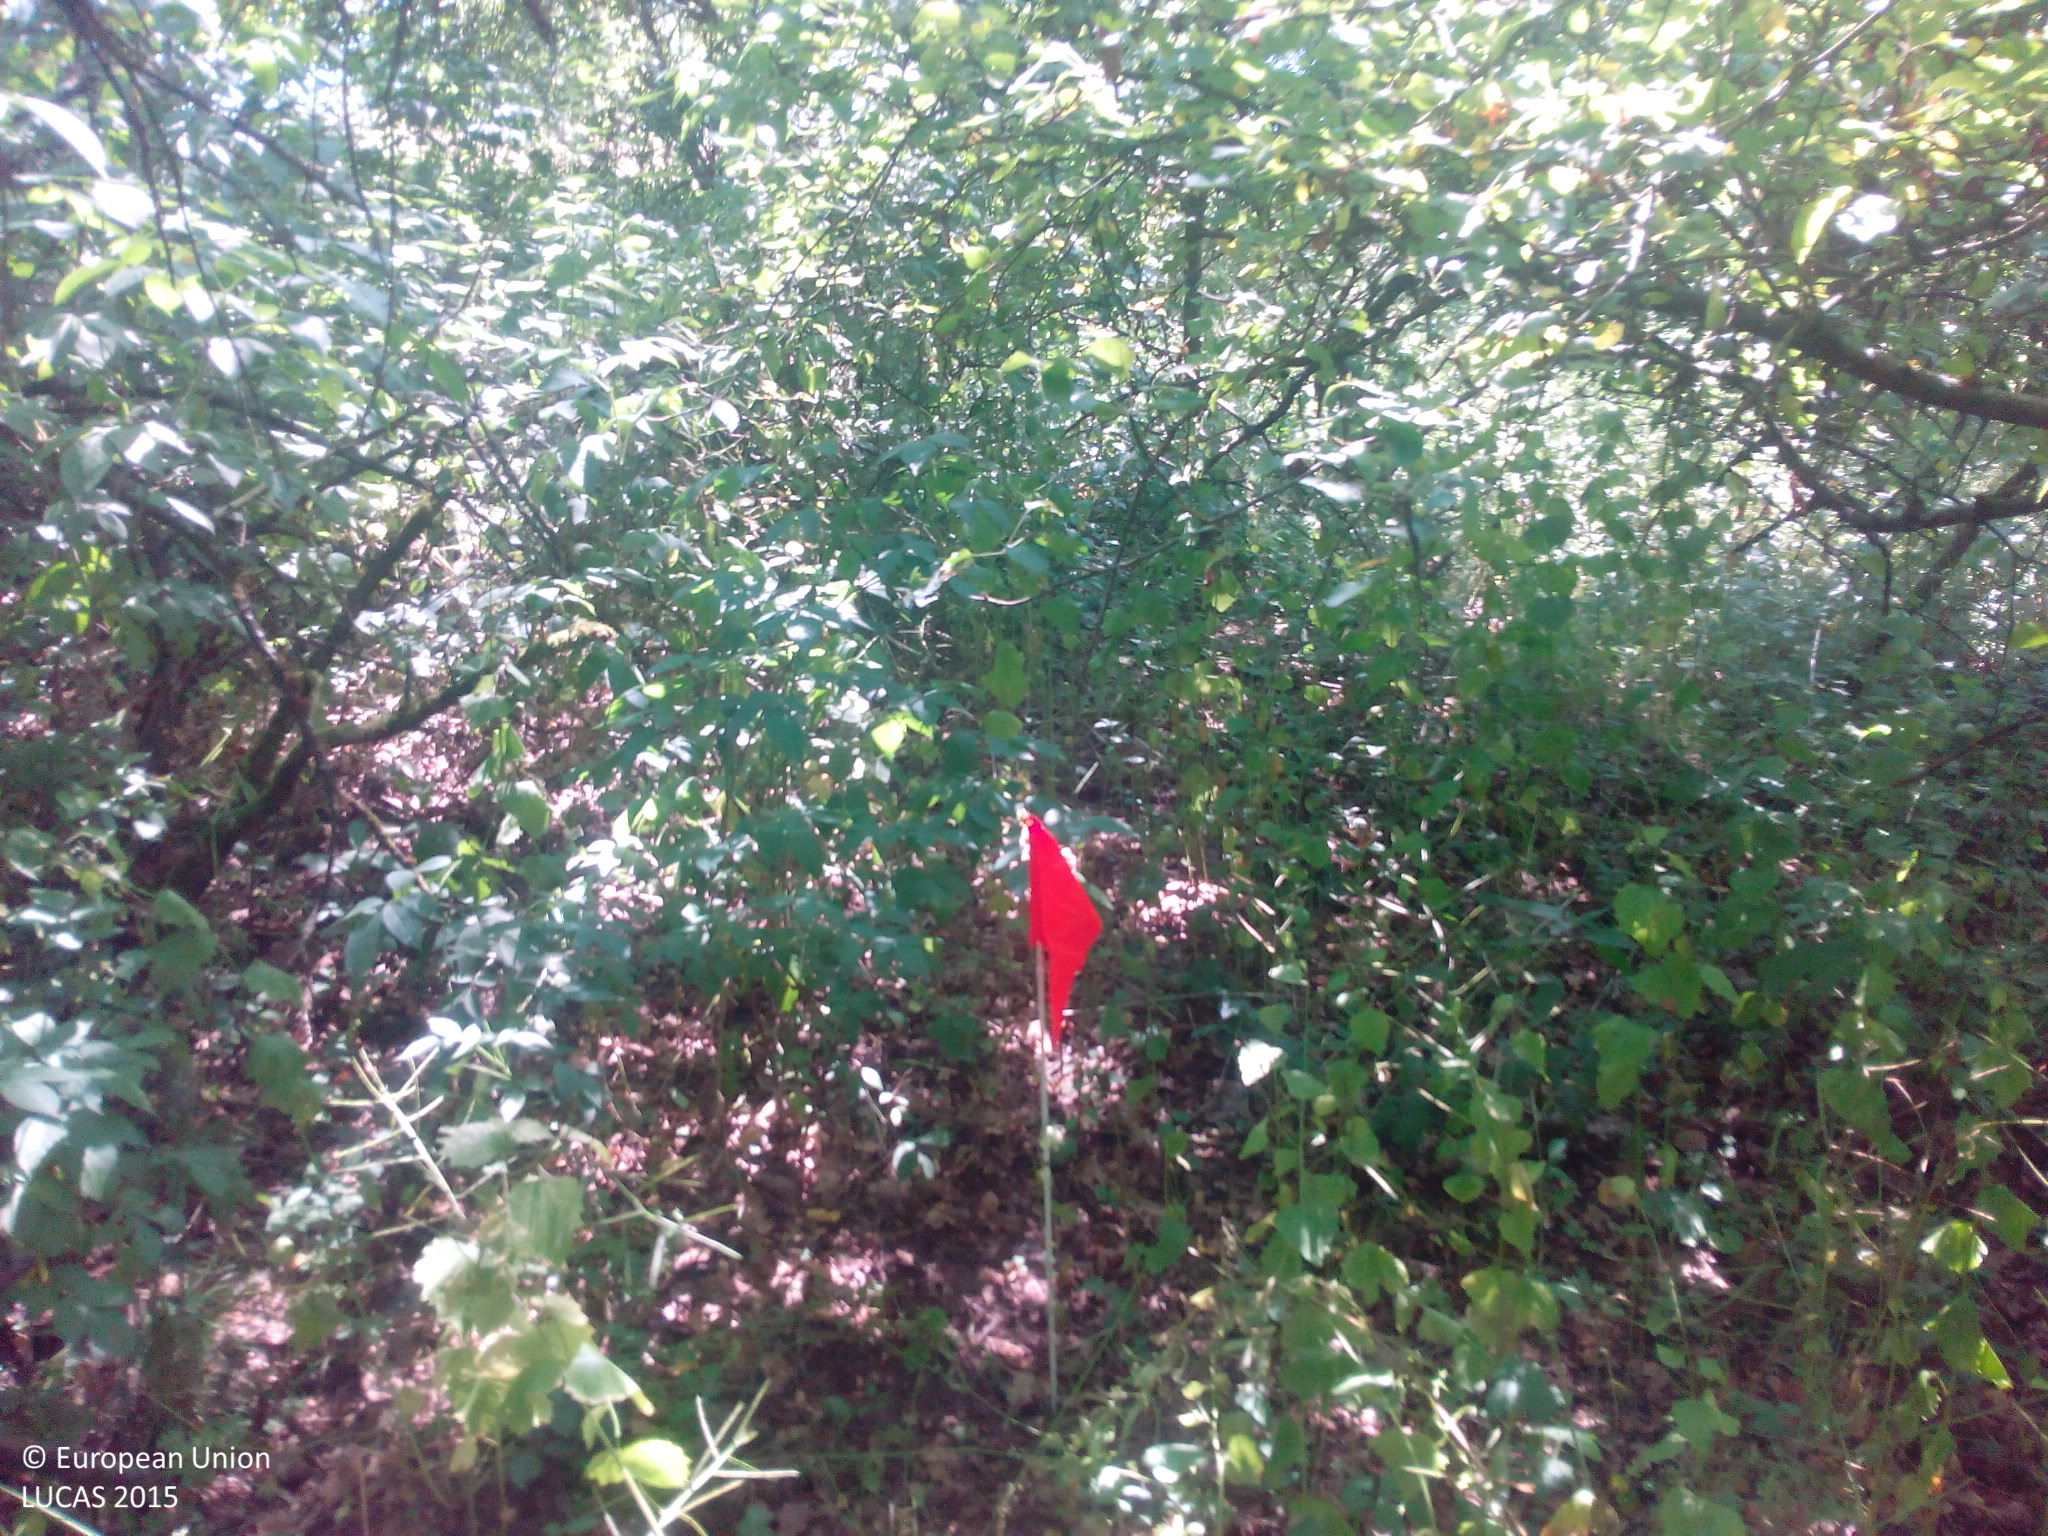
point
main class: Woodland
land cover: Broadleaved woodland
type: mesophytic deciduous forest
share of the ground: > 75 %
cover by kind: broadleaved forest trees 90 %, herbaceous plants 10 %
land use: Semi-natural and natural areas not in use
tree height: > 5 m
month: July
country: DE
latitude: 50.1285
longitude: 10.6293
